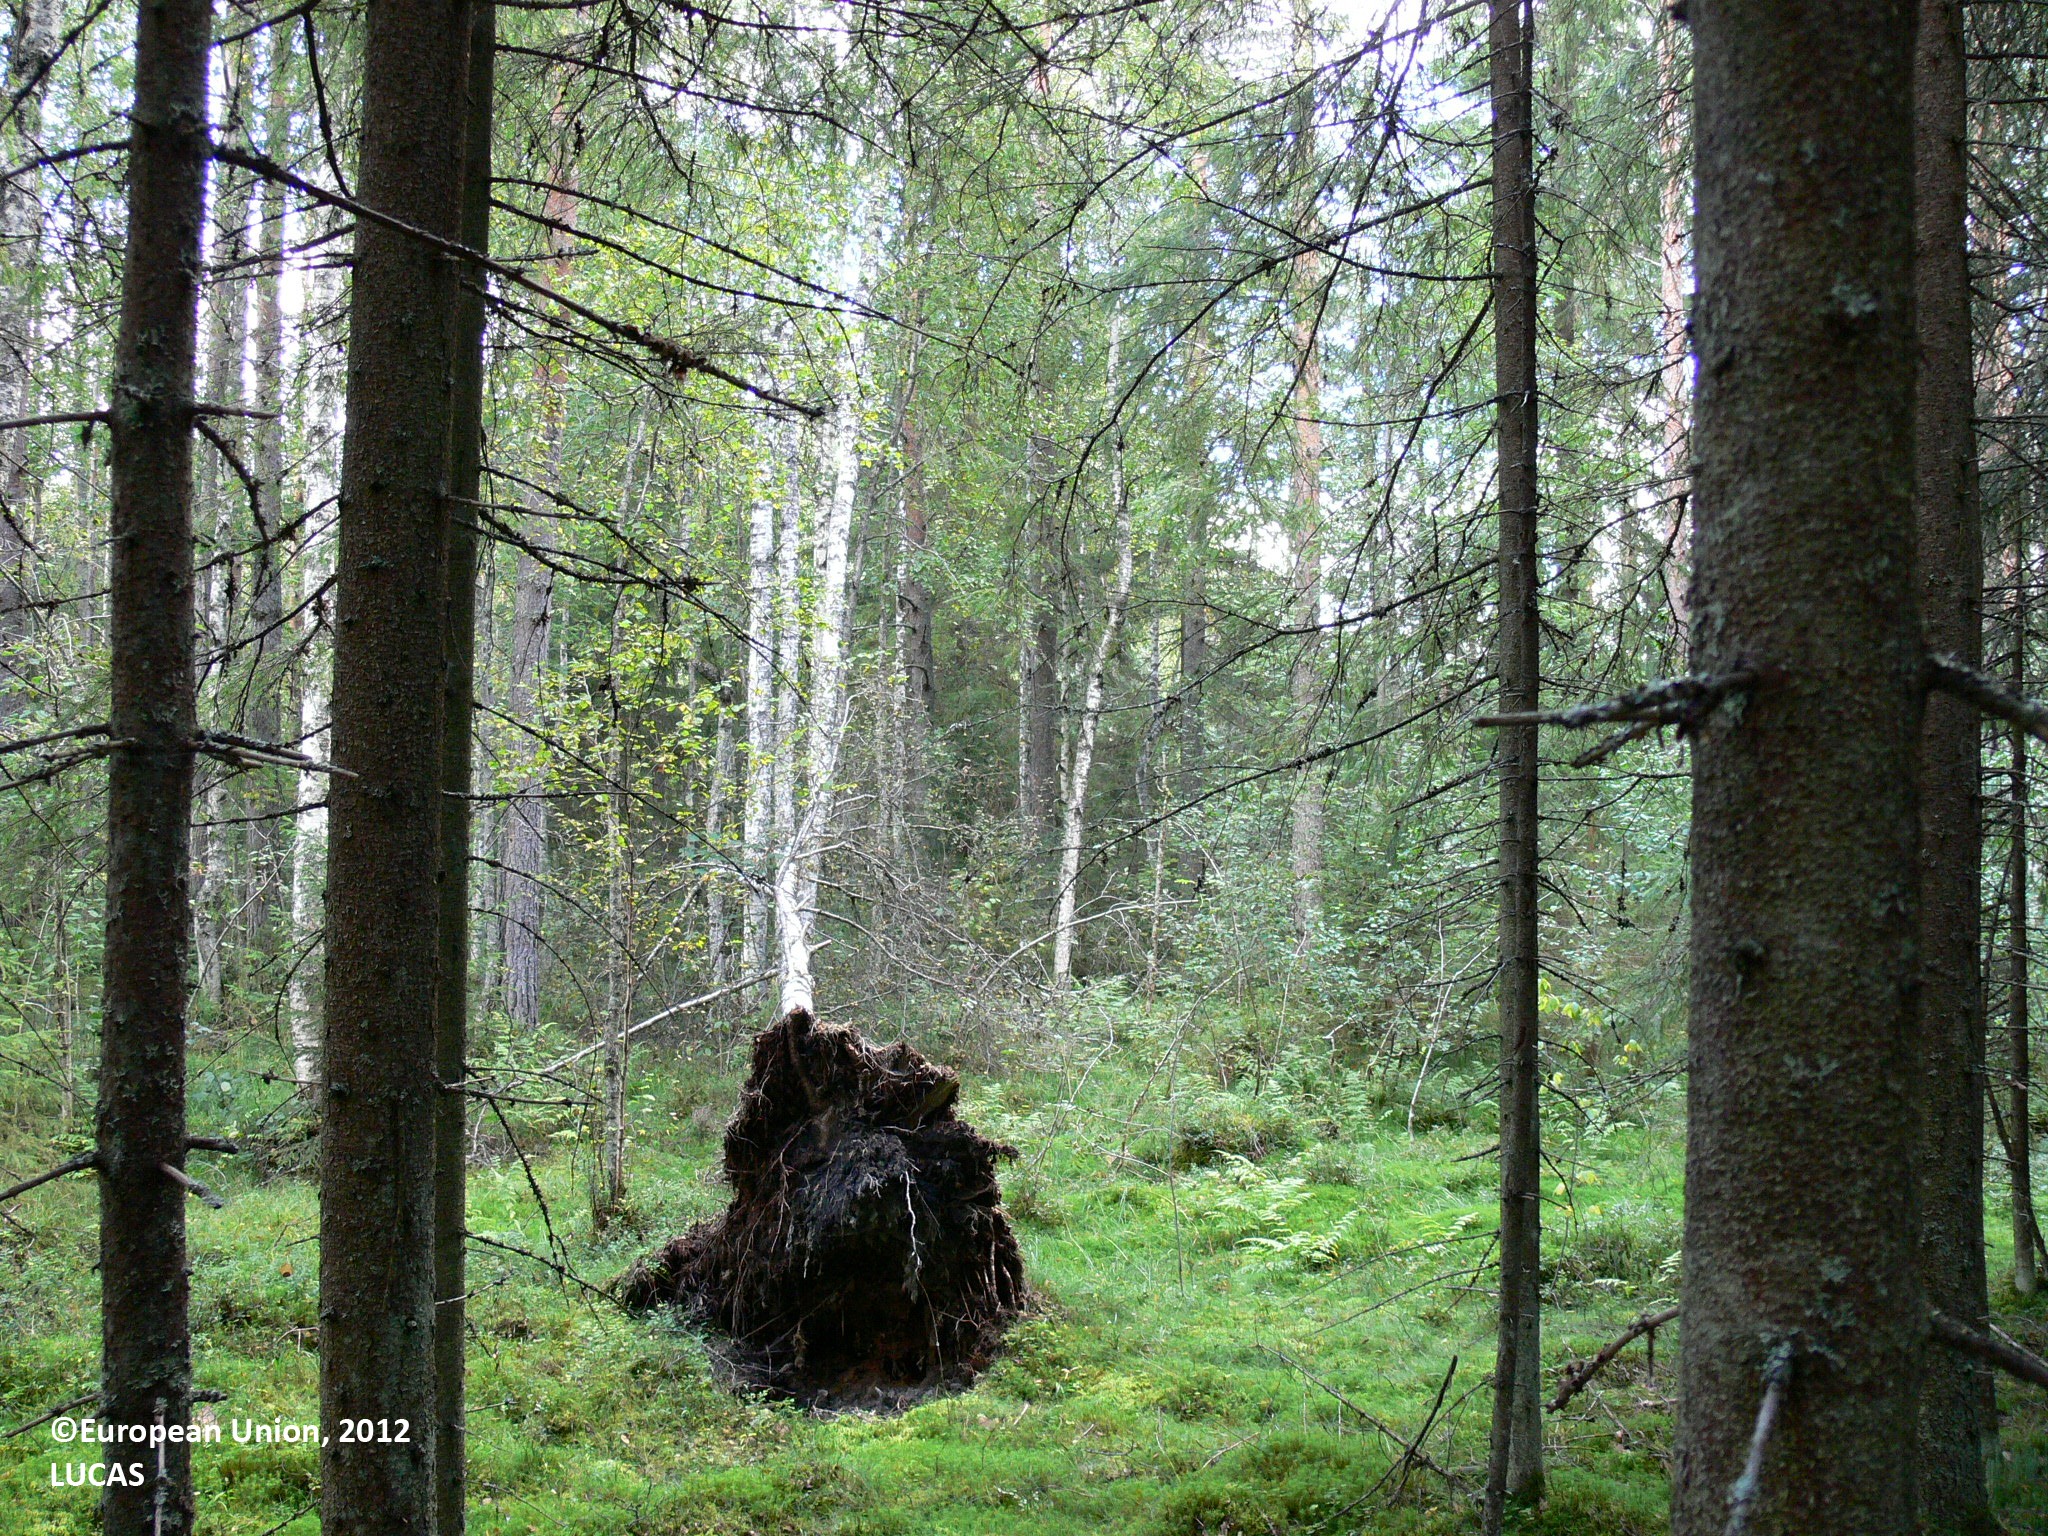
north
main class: Woodland
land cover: Other coniferous woodland
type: boreal forest
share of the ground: > 75 %
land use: Forestry
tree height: > 5 m
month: August
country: FI
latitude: 61.9783
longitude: 30.2546
